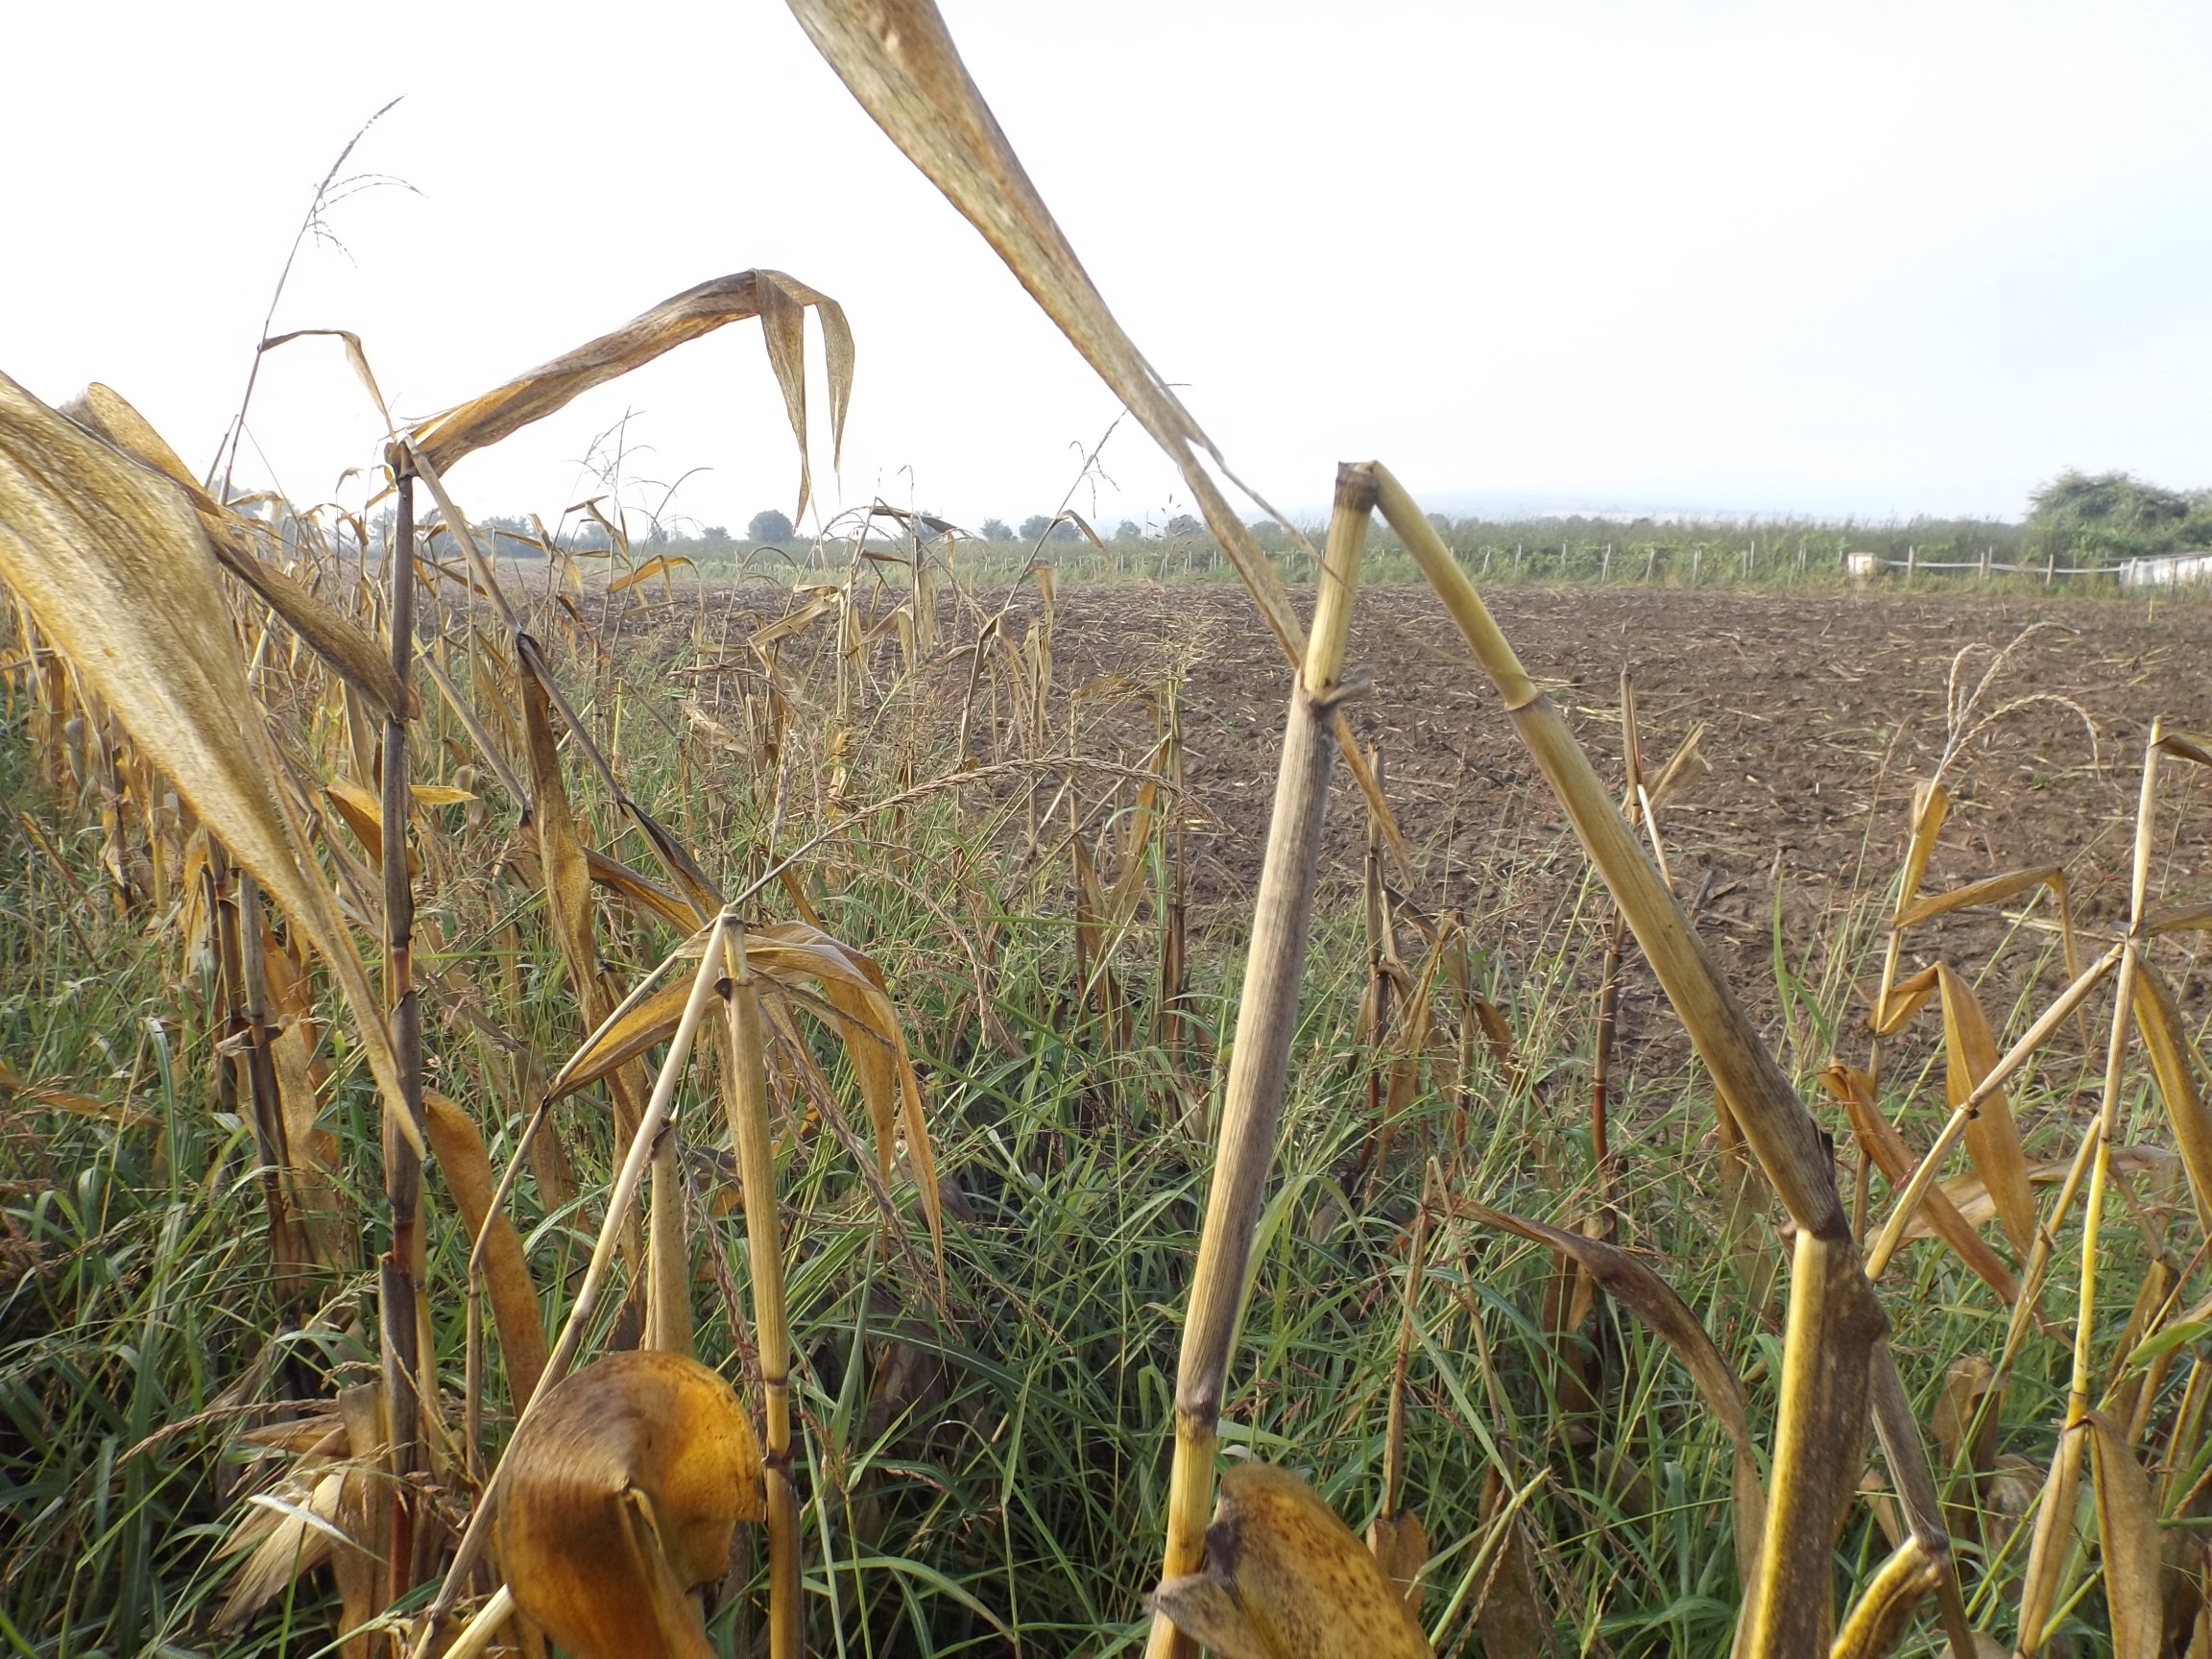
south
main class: Cropland
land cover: Maize
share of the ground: > 75 %
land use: Agriculture (excluding fallow land and kitchen gardens)
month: September
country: BG
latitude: 44.0227
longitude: 26.5420
